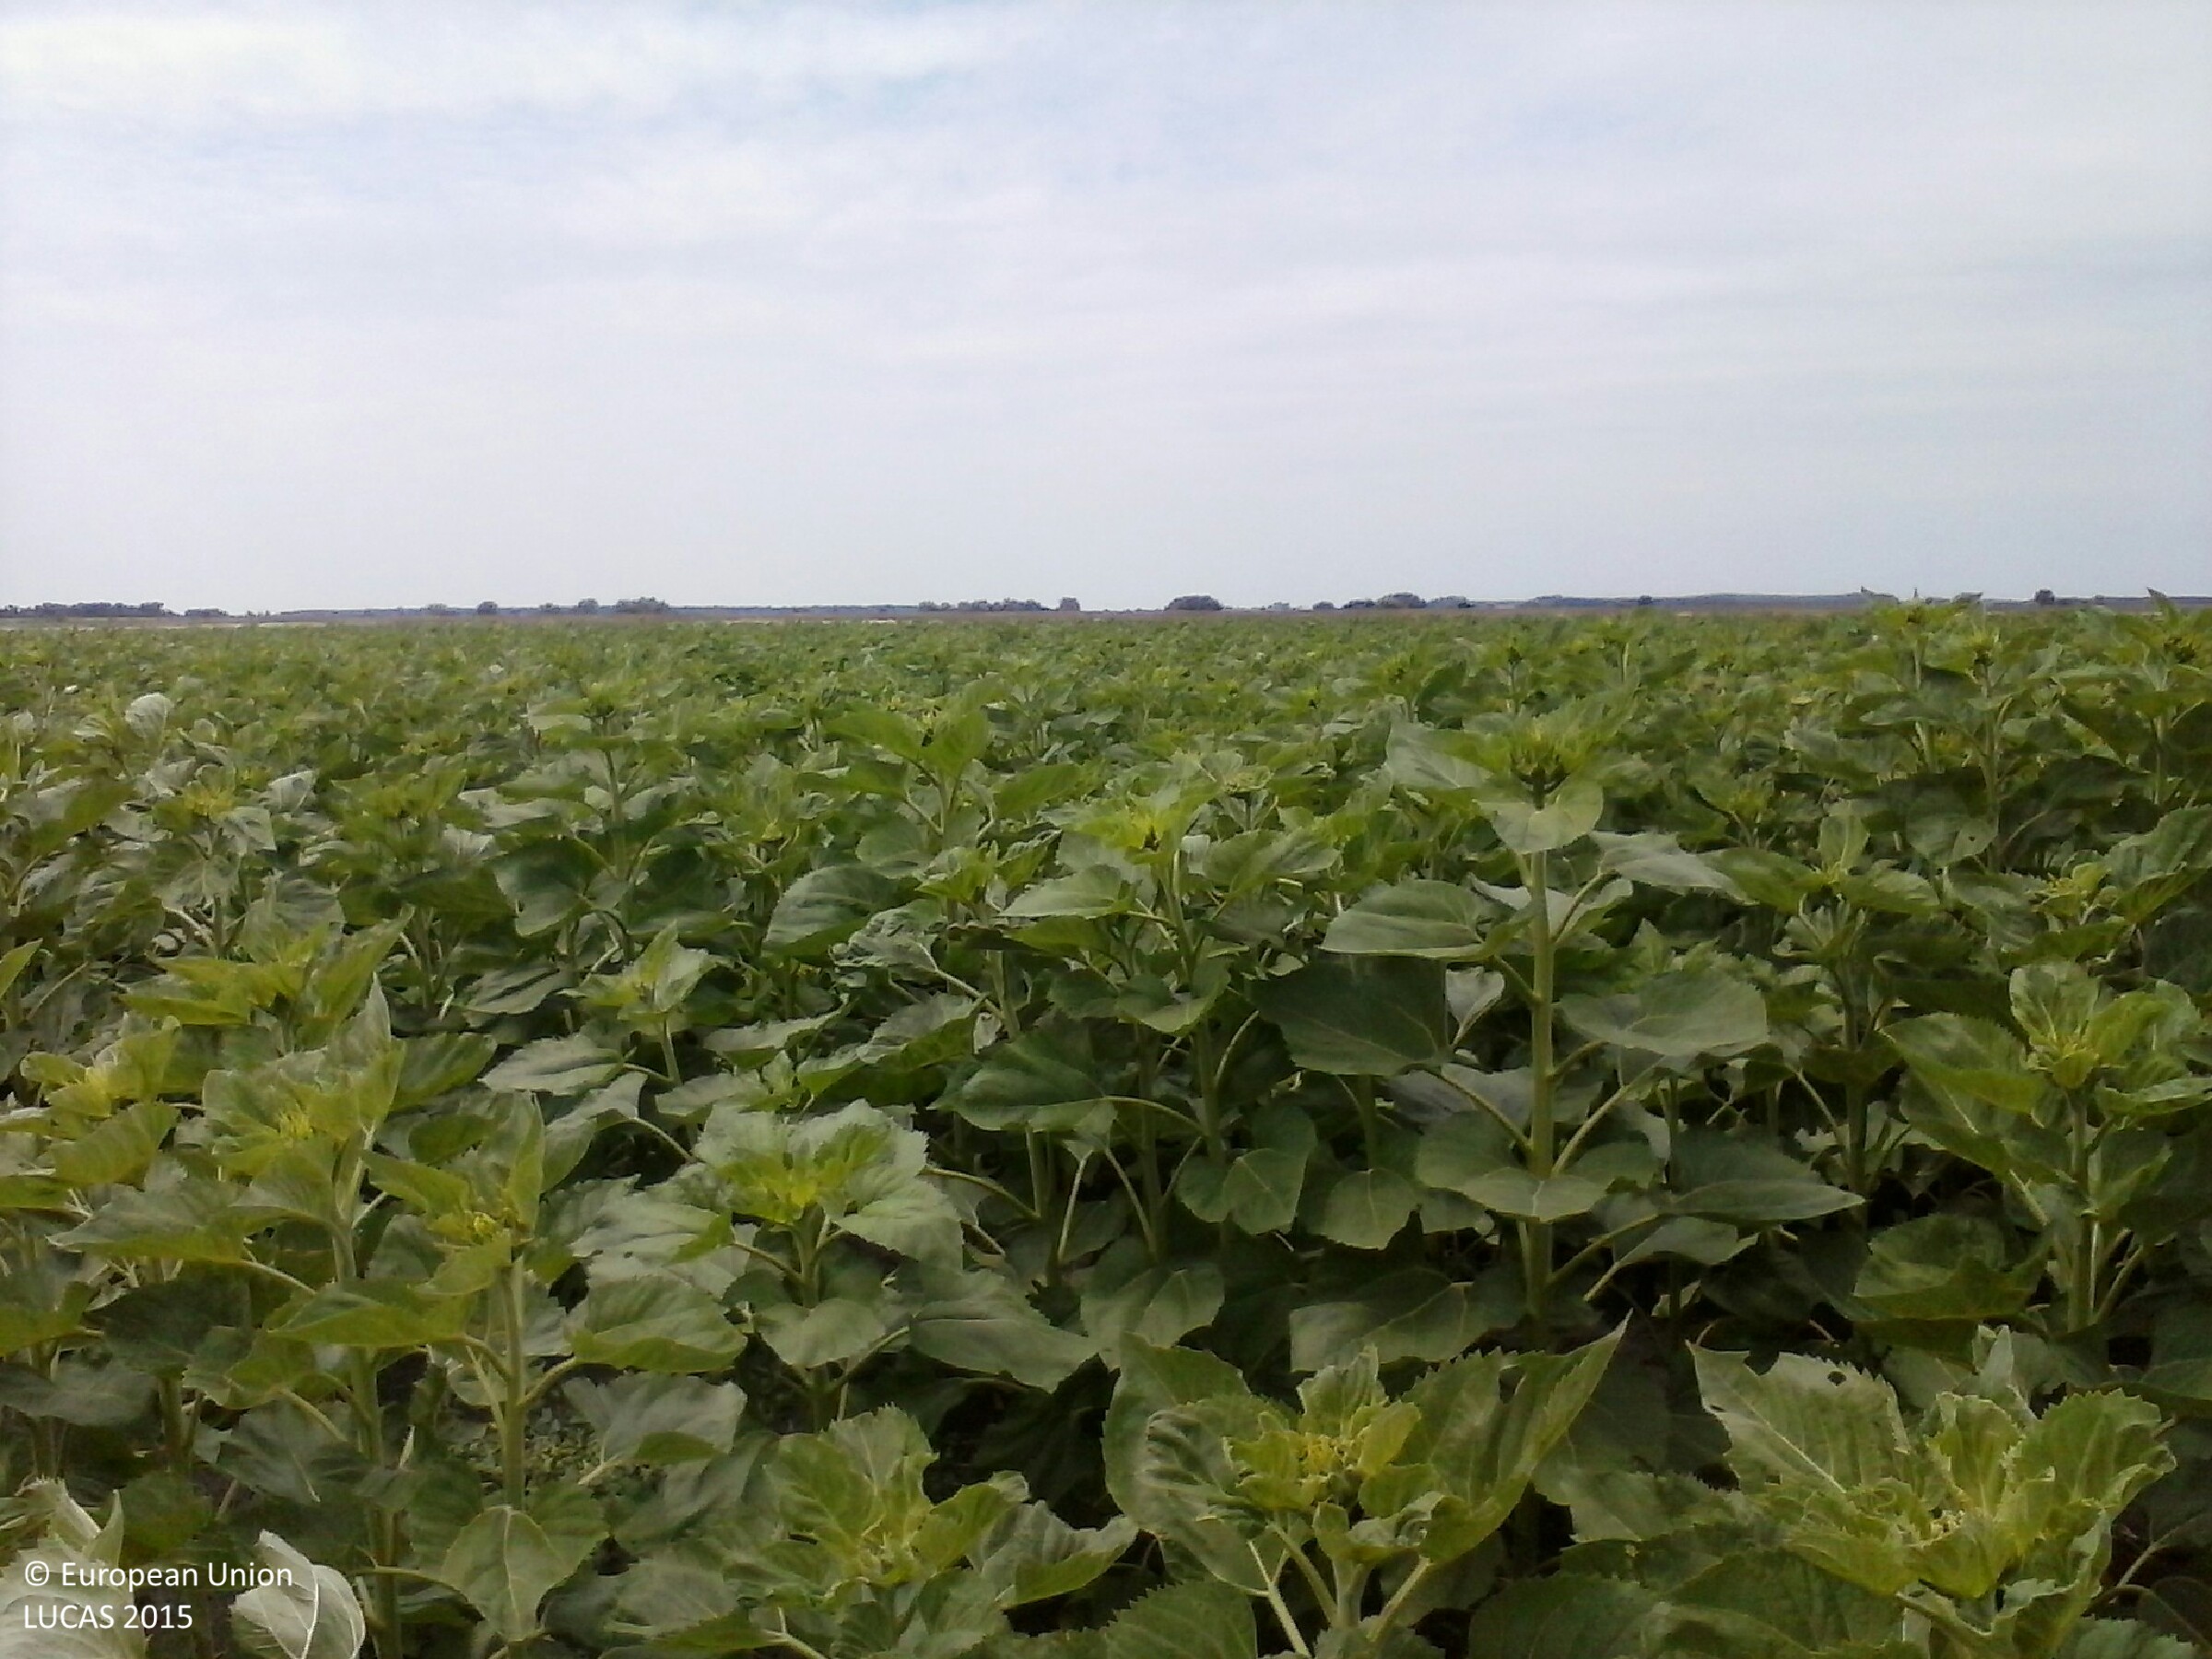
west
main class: Cropland
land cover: Sunflower
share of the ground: > 75 %
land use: Agriculture (excluding fallow land and kitchen gardens)
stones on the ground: < 10 %
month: June
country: HU
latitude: 46.1798
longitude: 20.2959
